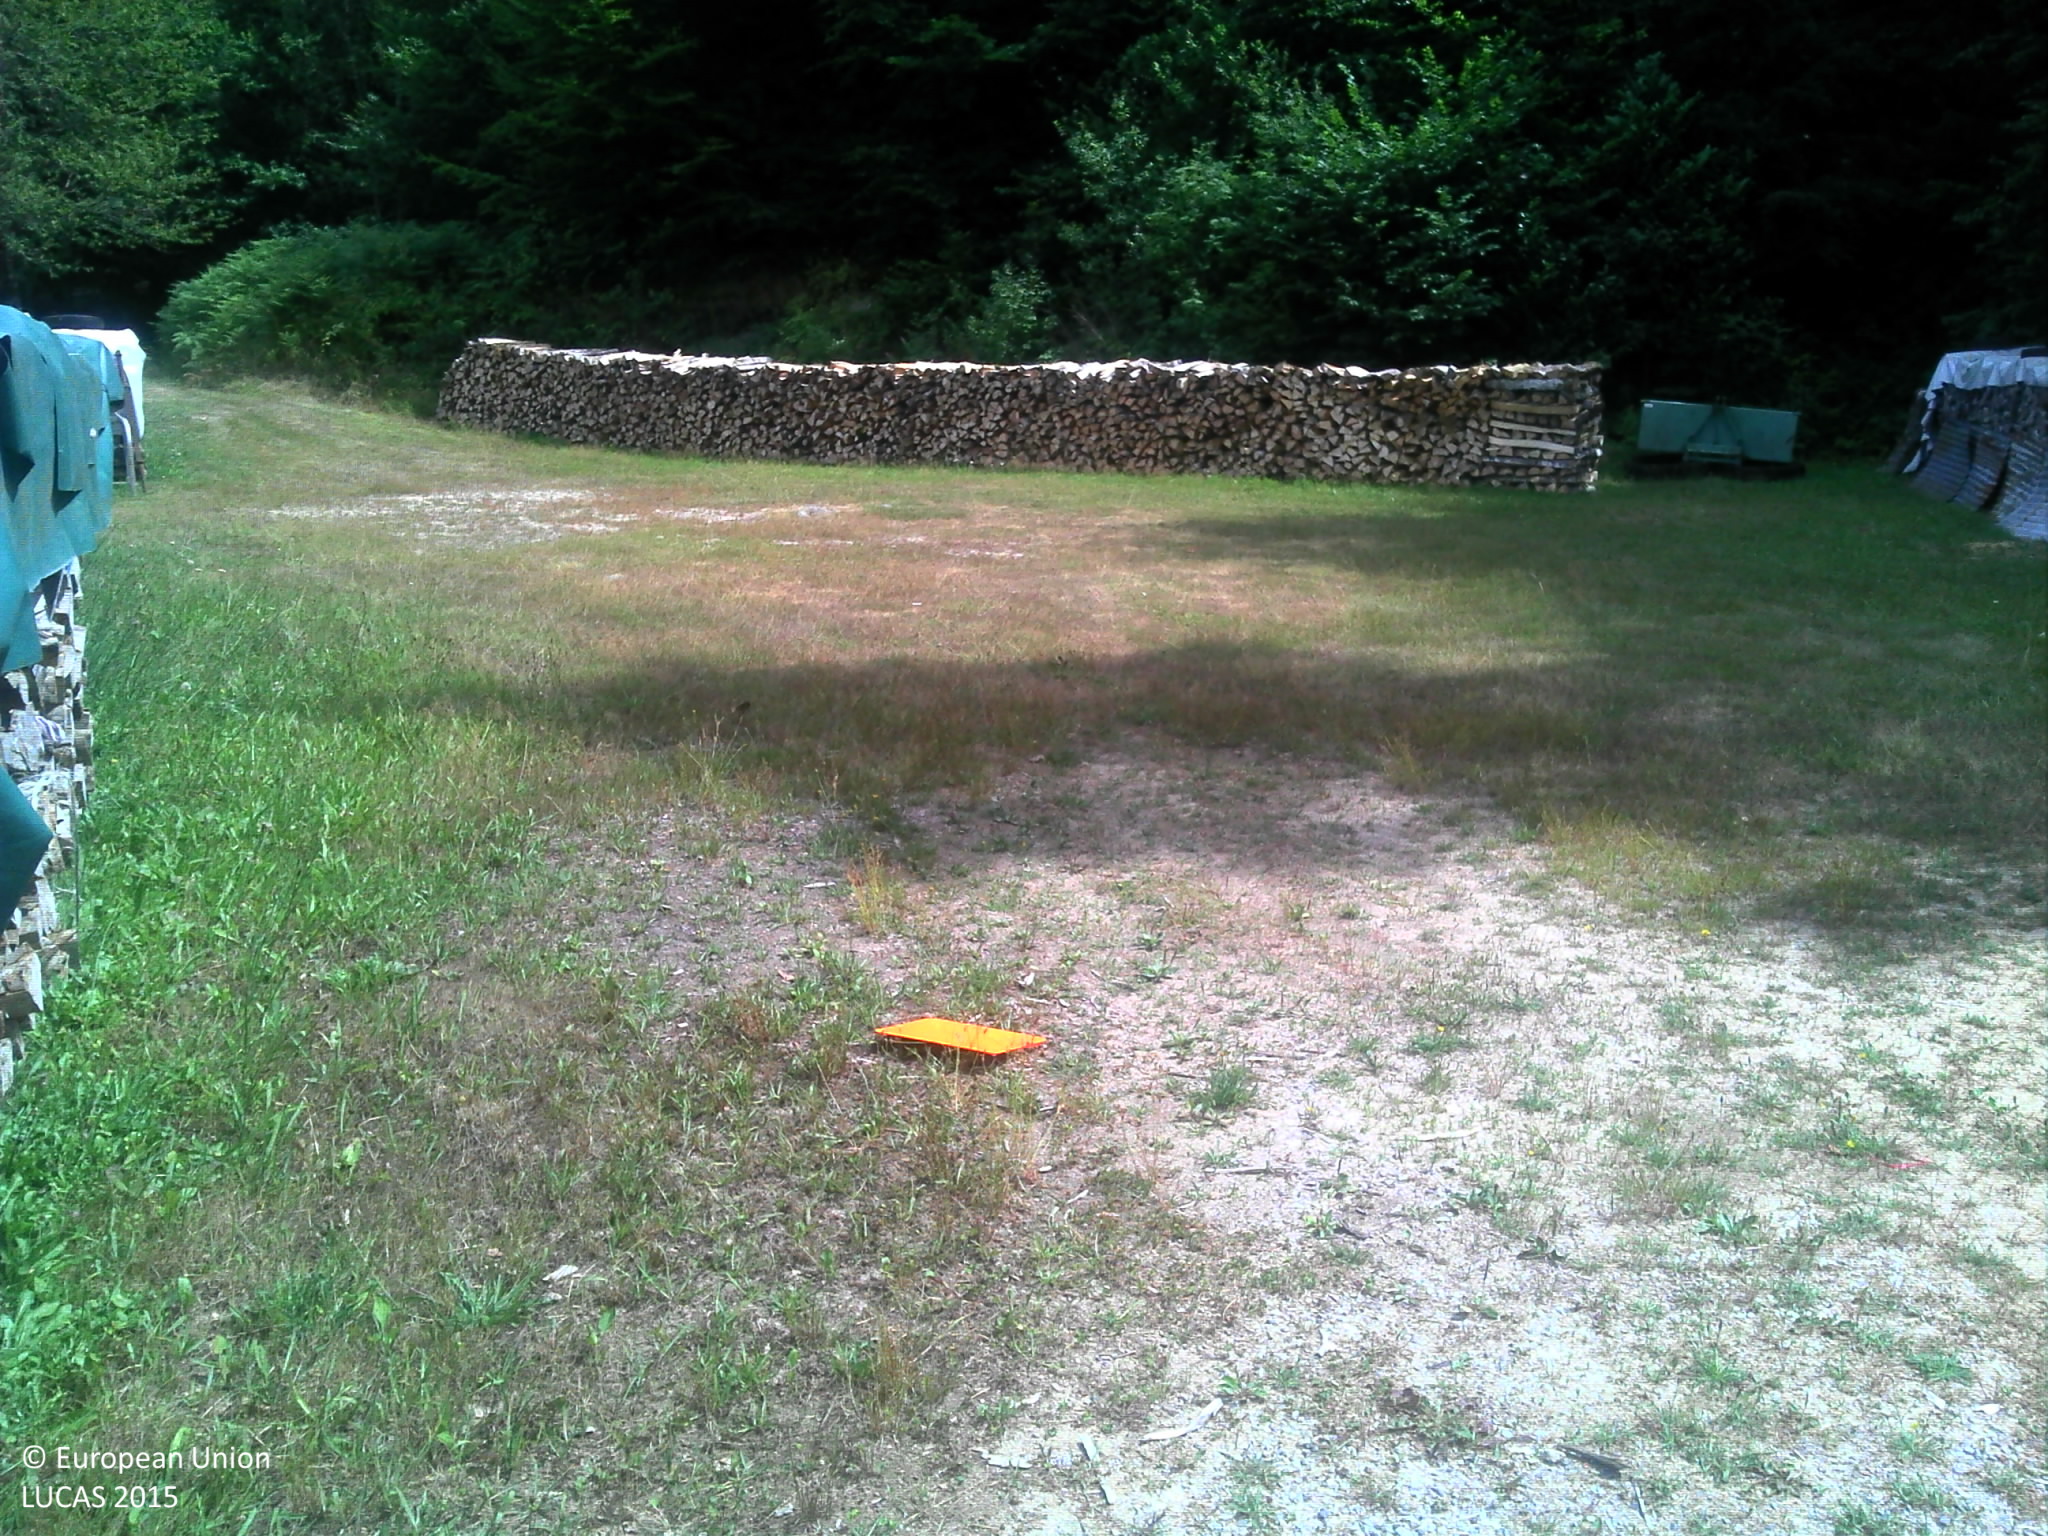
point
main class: Grassland
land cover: Grassland without tree/shrub cover
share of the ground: > 75 %
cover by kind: herbaceous plants 95 %, shrubs 5 %
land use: Forestry
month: July
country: FR
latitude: 45.6395
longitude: 1.8225
